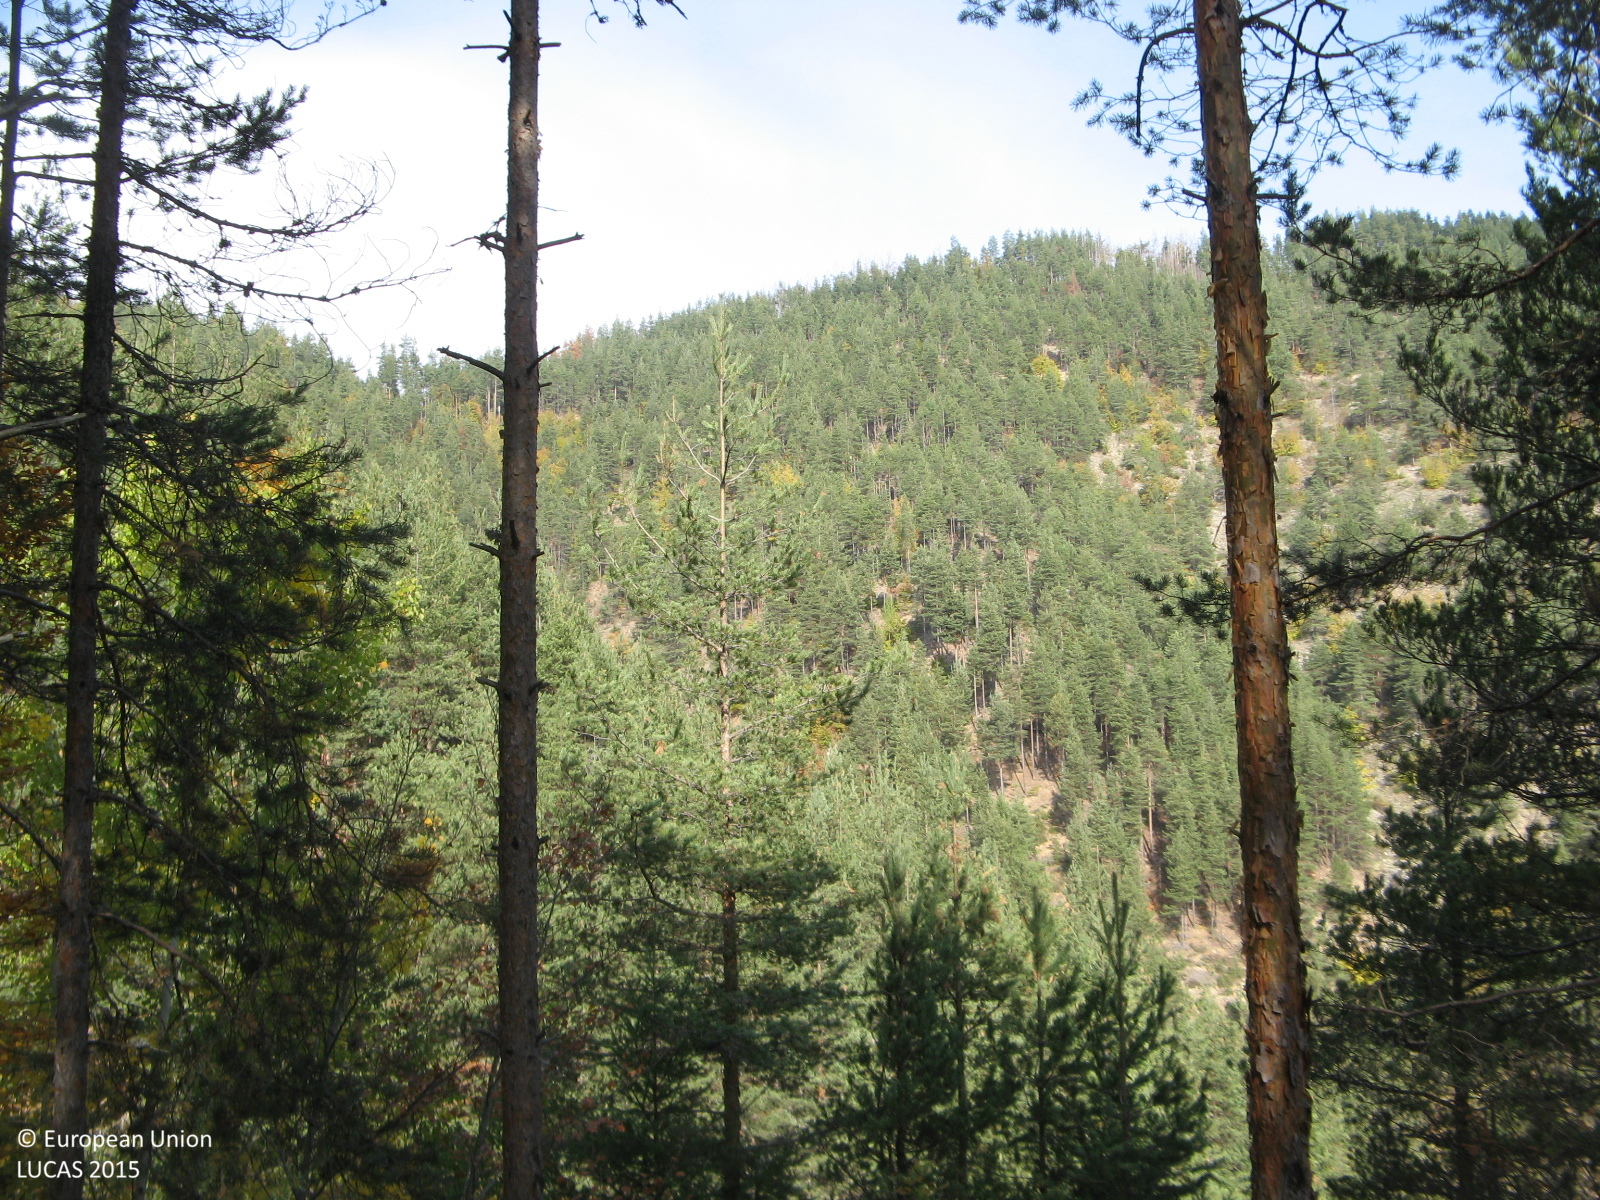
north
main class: Woodland
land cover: Pine dominated mixed woodland
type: alpine coniferous forest
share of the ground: > 75 %
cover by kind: coniferous forest trees 70 %, broadleaved forest trees 25 %, lichens and mosses 5 %
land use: Forestry
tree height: > 5 m
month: October
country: BG
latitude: 41.5343
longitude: 24.8483
